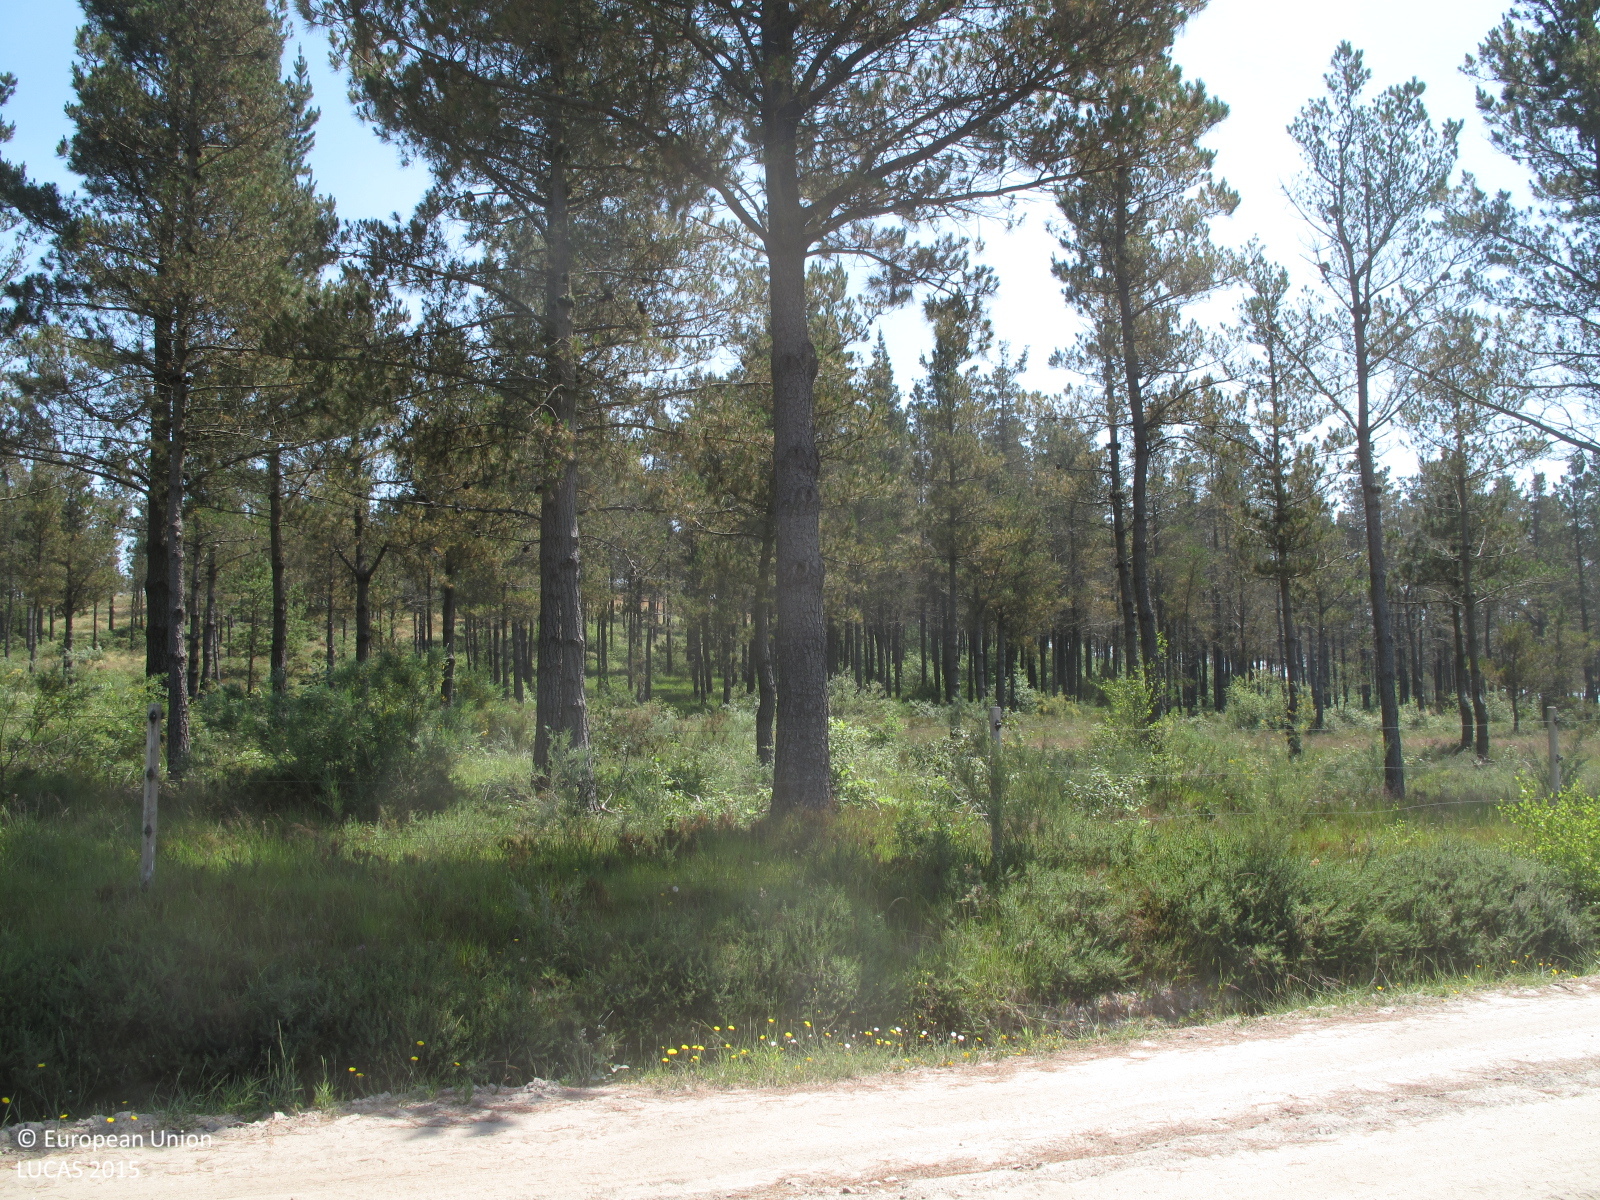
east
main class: Woodland
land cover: Pine dominated mixed woodland
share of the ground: 10 - 25 %
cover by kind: shrubs 60 %, herbaceous plants 30 %, coniferous forest trees 5 %, broadleaved forest trees 5 %
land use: Forestry
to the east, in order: Pine dominated mixed woodland; Tracks; Fences; Pine dominated coniferous woodland
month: June
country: ES
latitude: 43.2336
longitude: -7.9330
